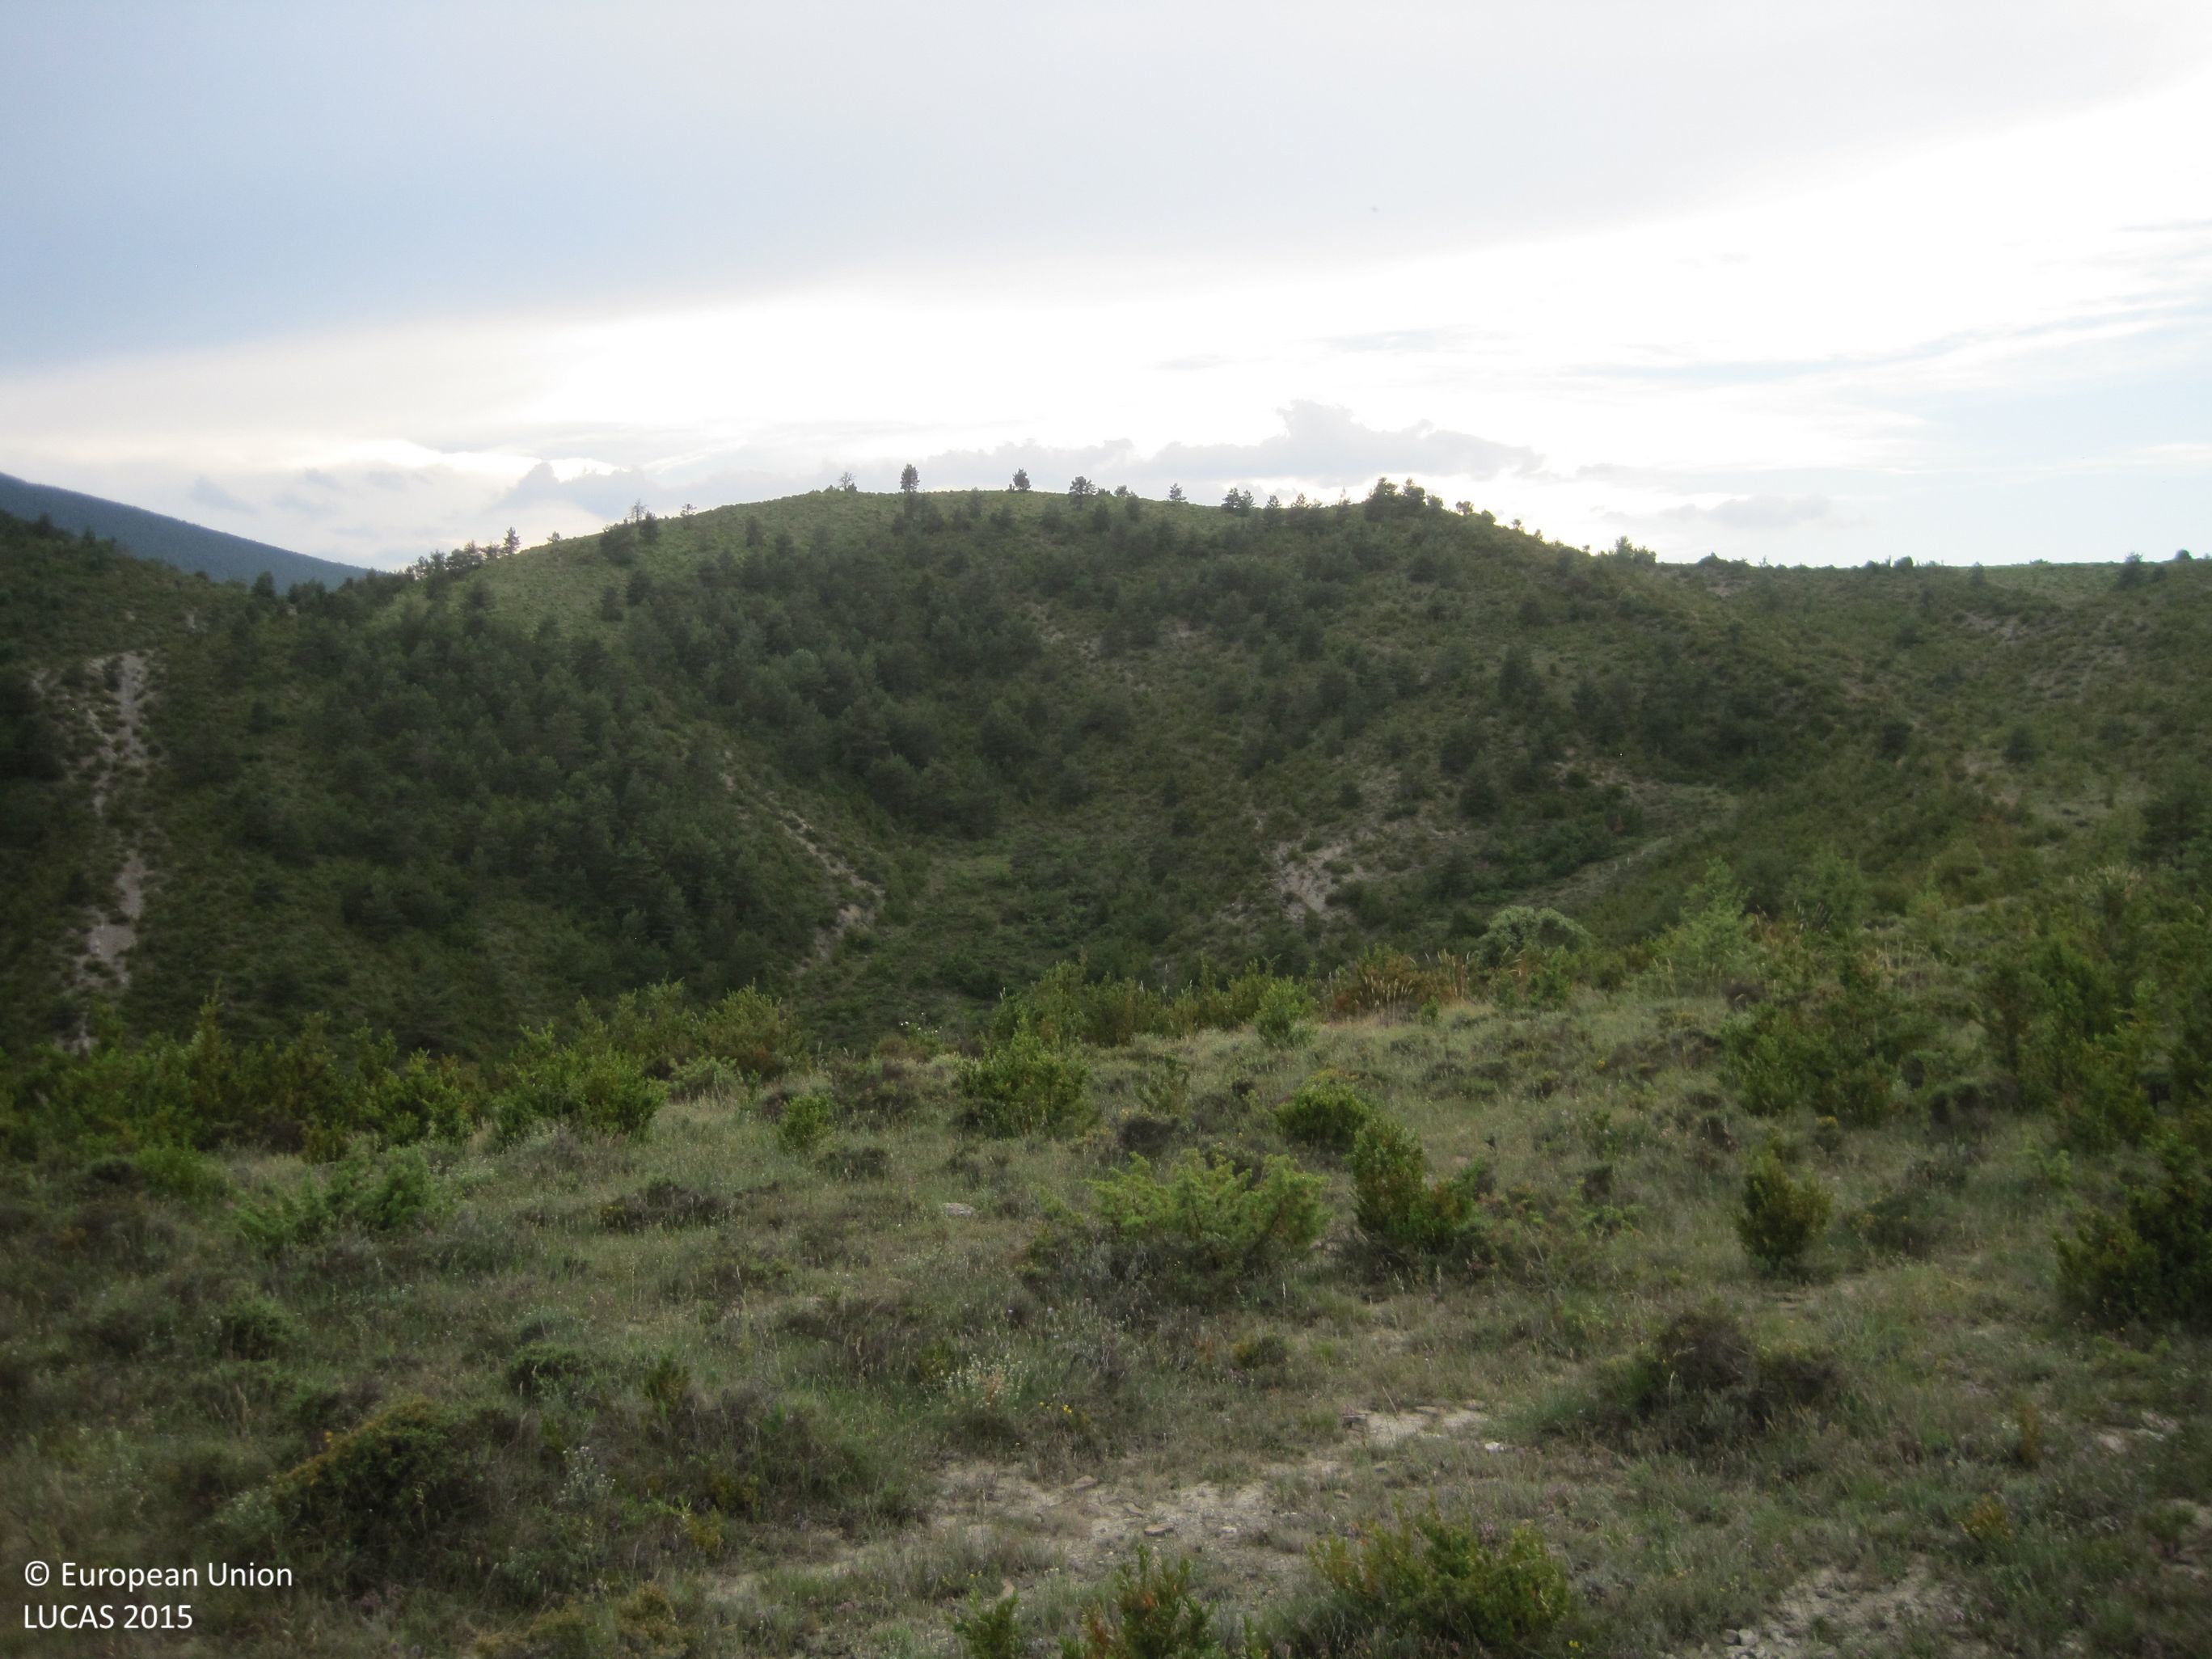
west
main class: Shrubland
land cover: Shrubland without tree cover
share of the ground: > 75 %
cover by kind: shrubs 40 %, herbaceous plants 30 %, consolidated bare surface 30 %
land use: Semi-natural and natural areas not in use
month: June
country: ES
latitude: 42.7274
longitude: -1.1595
